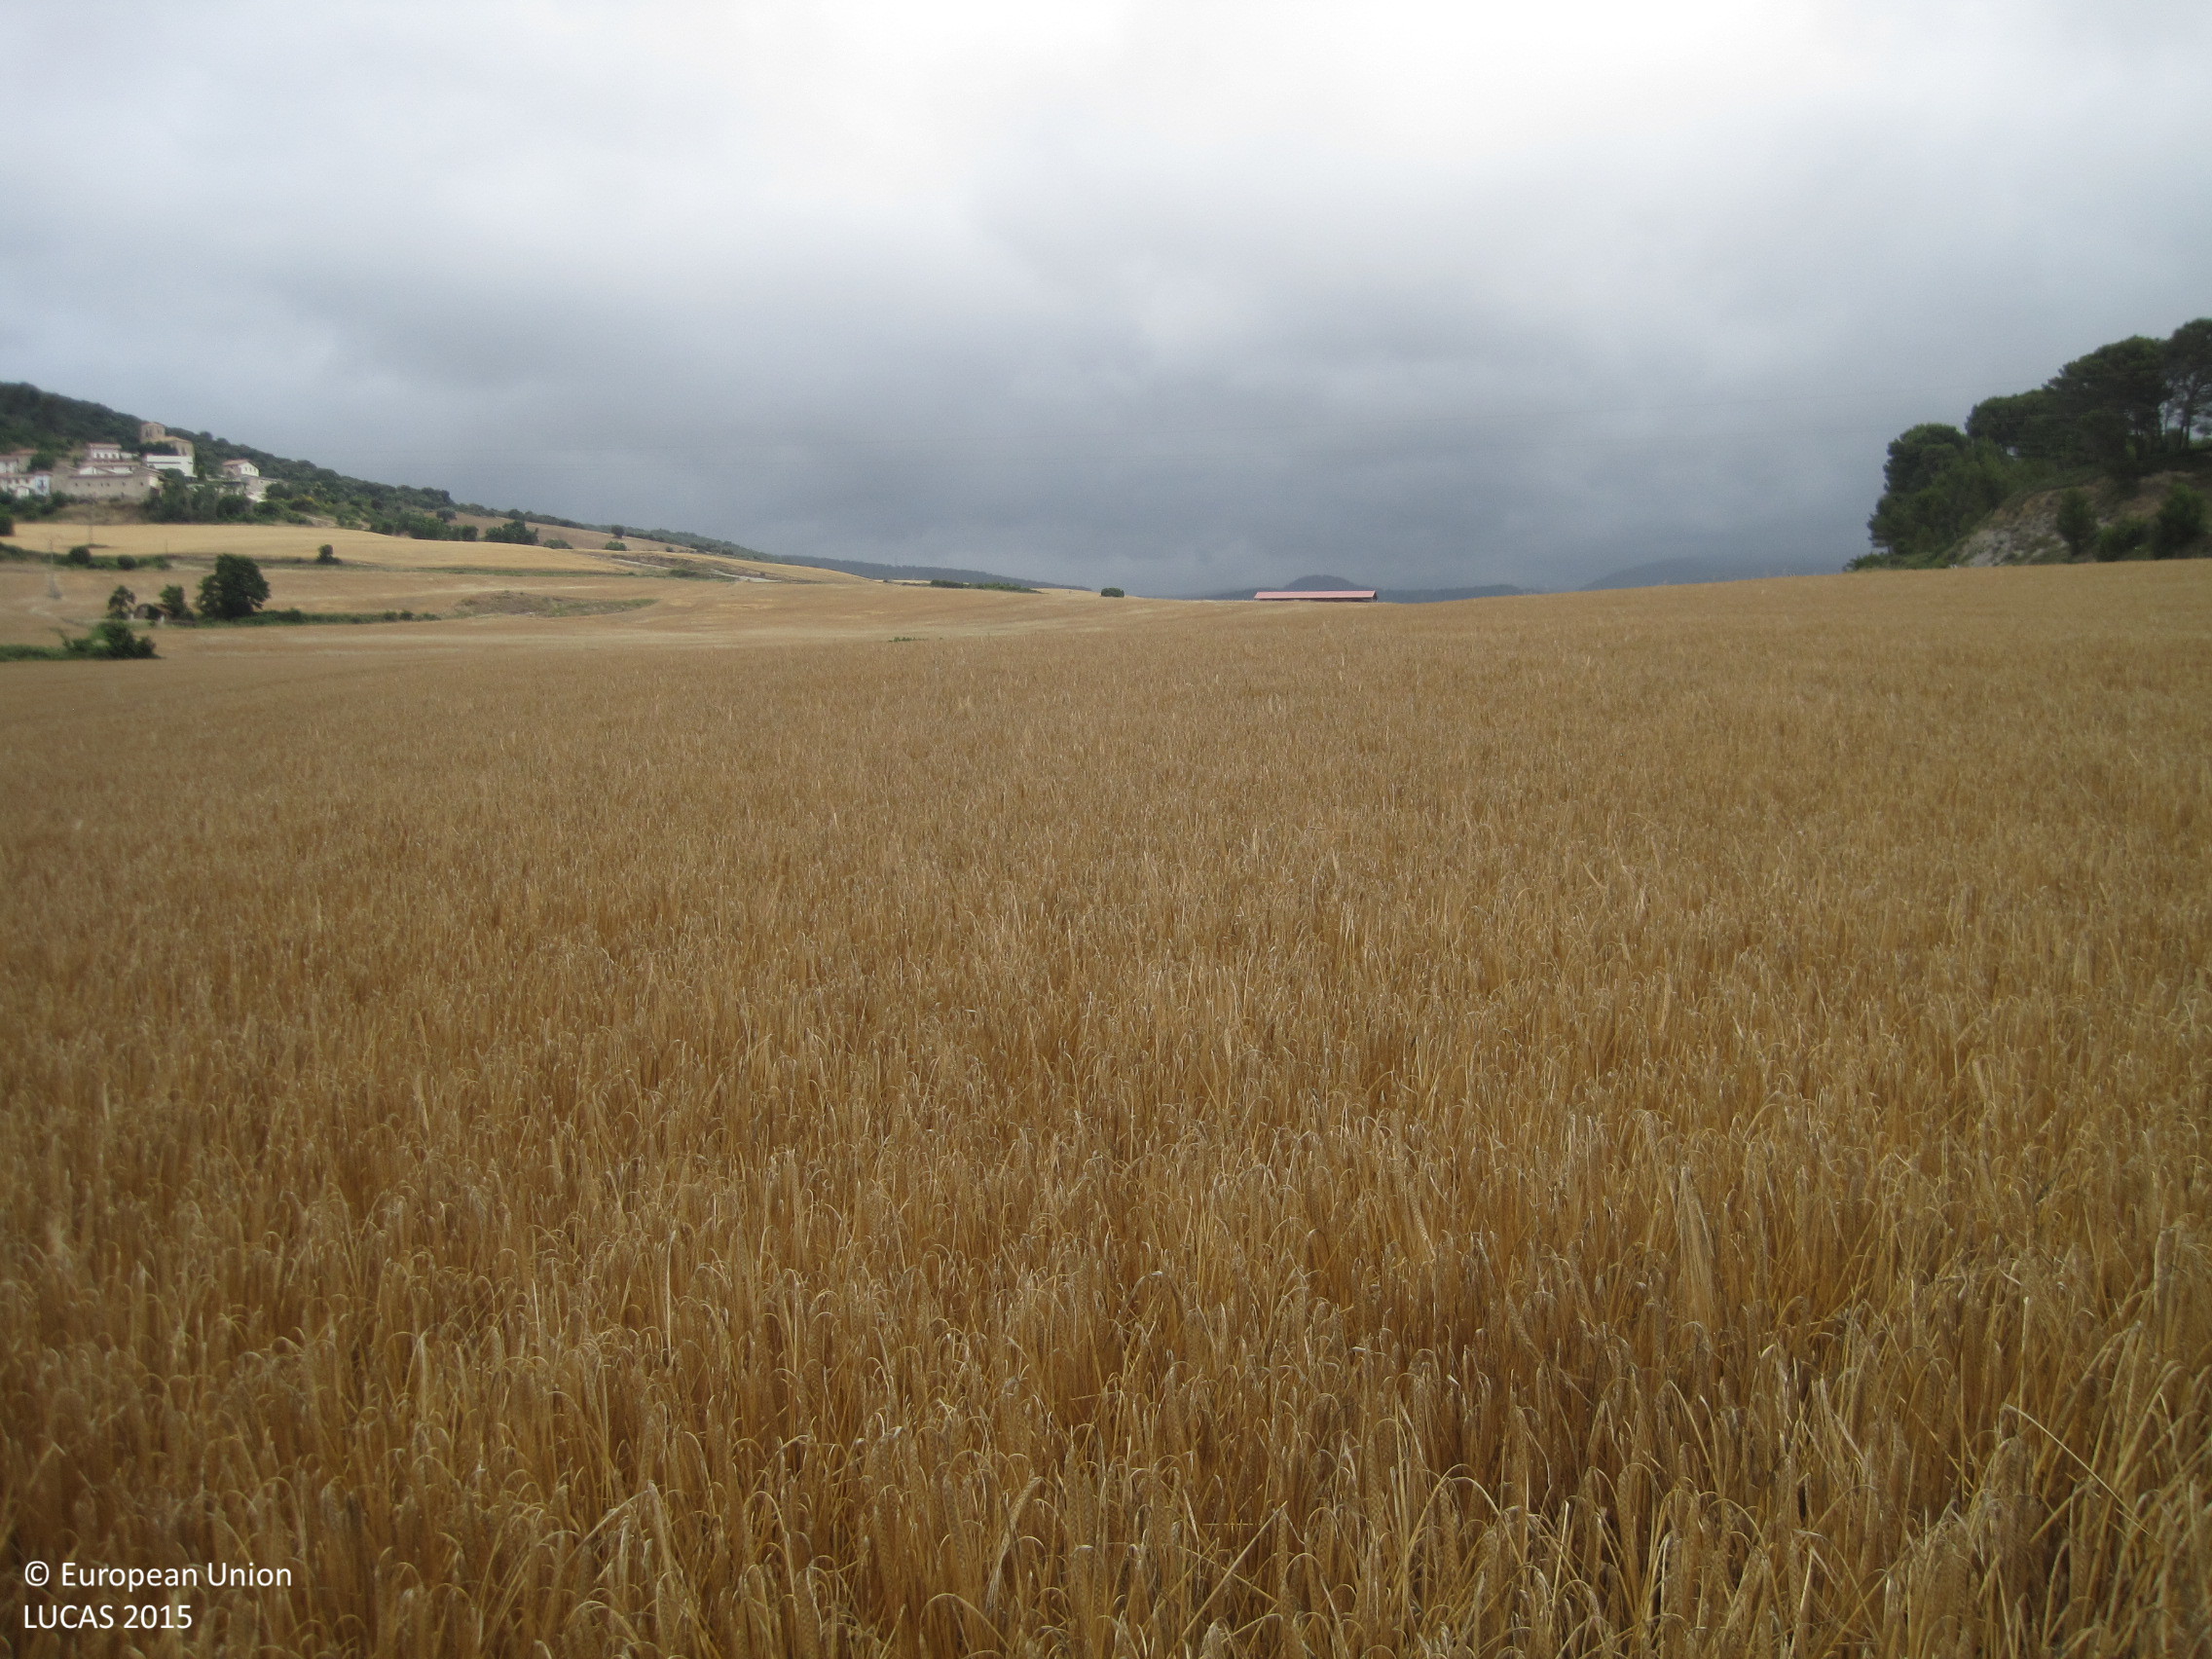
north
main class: Cropland
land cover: Barley
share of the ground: > 75 %
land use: Agriculture (excluding fallow land and kitchen gardens)
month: June
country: ES
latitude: 42.8397
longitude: -1.7740
